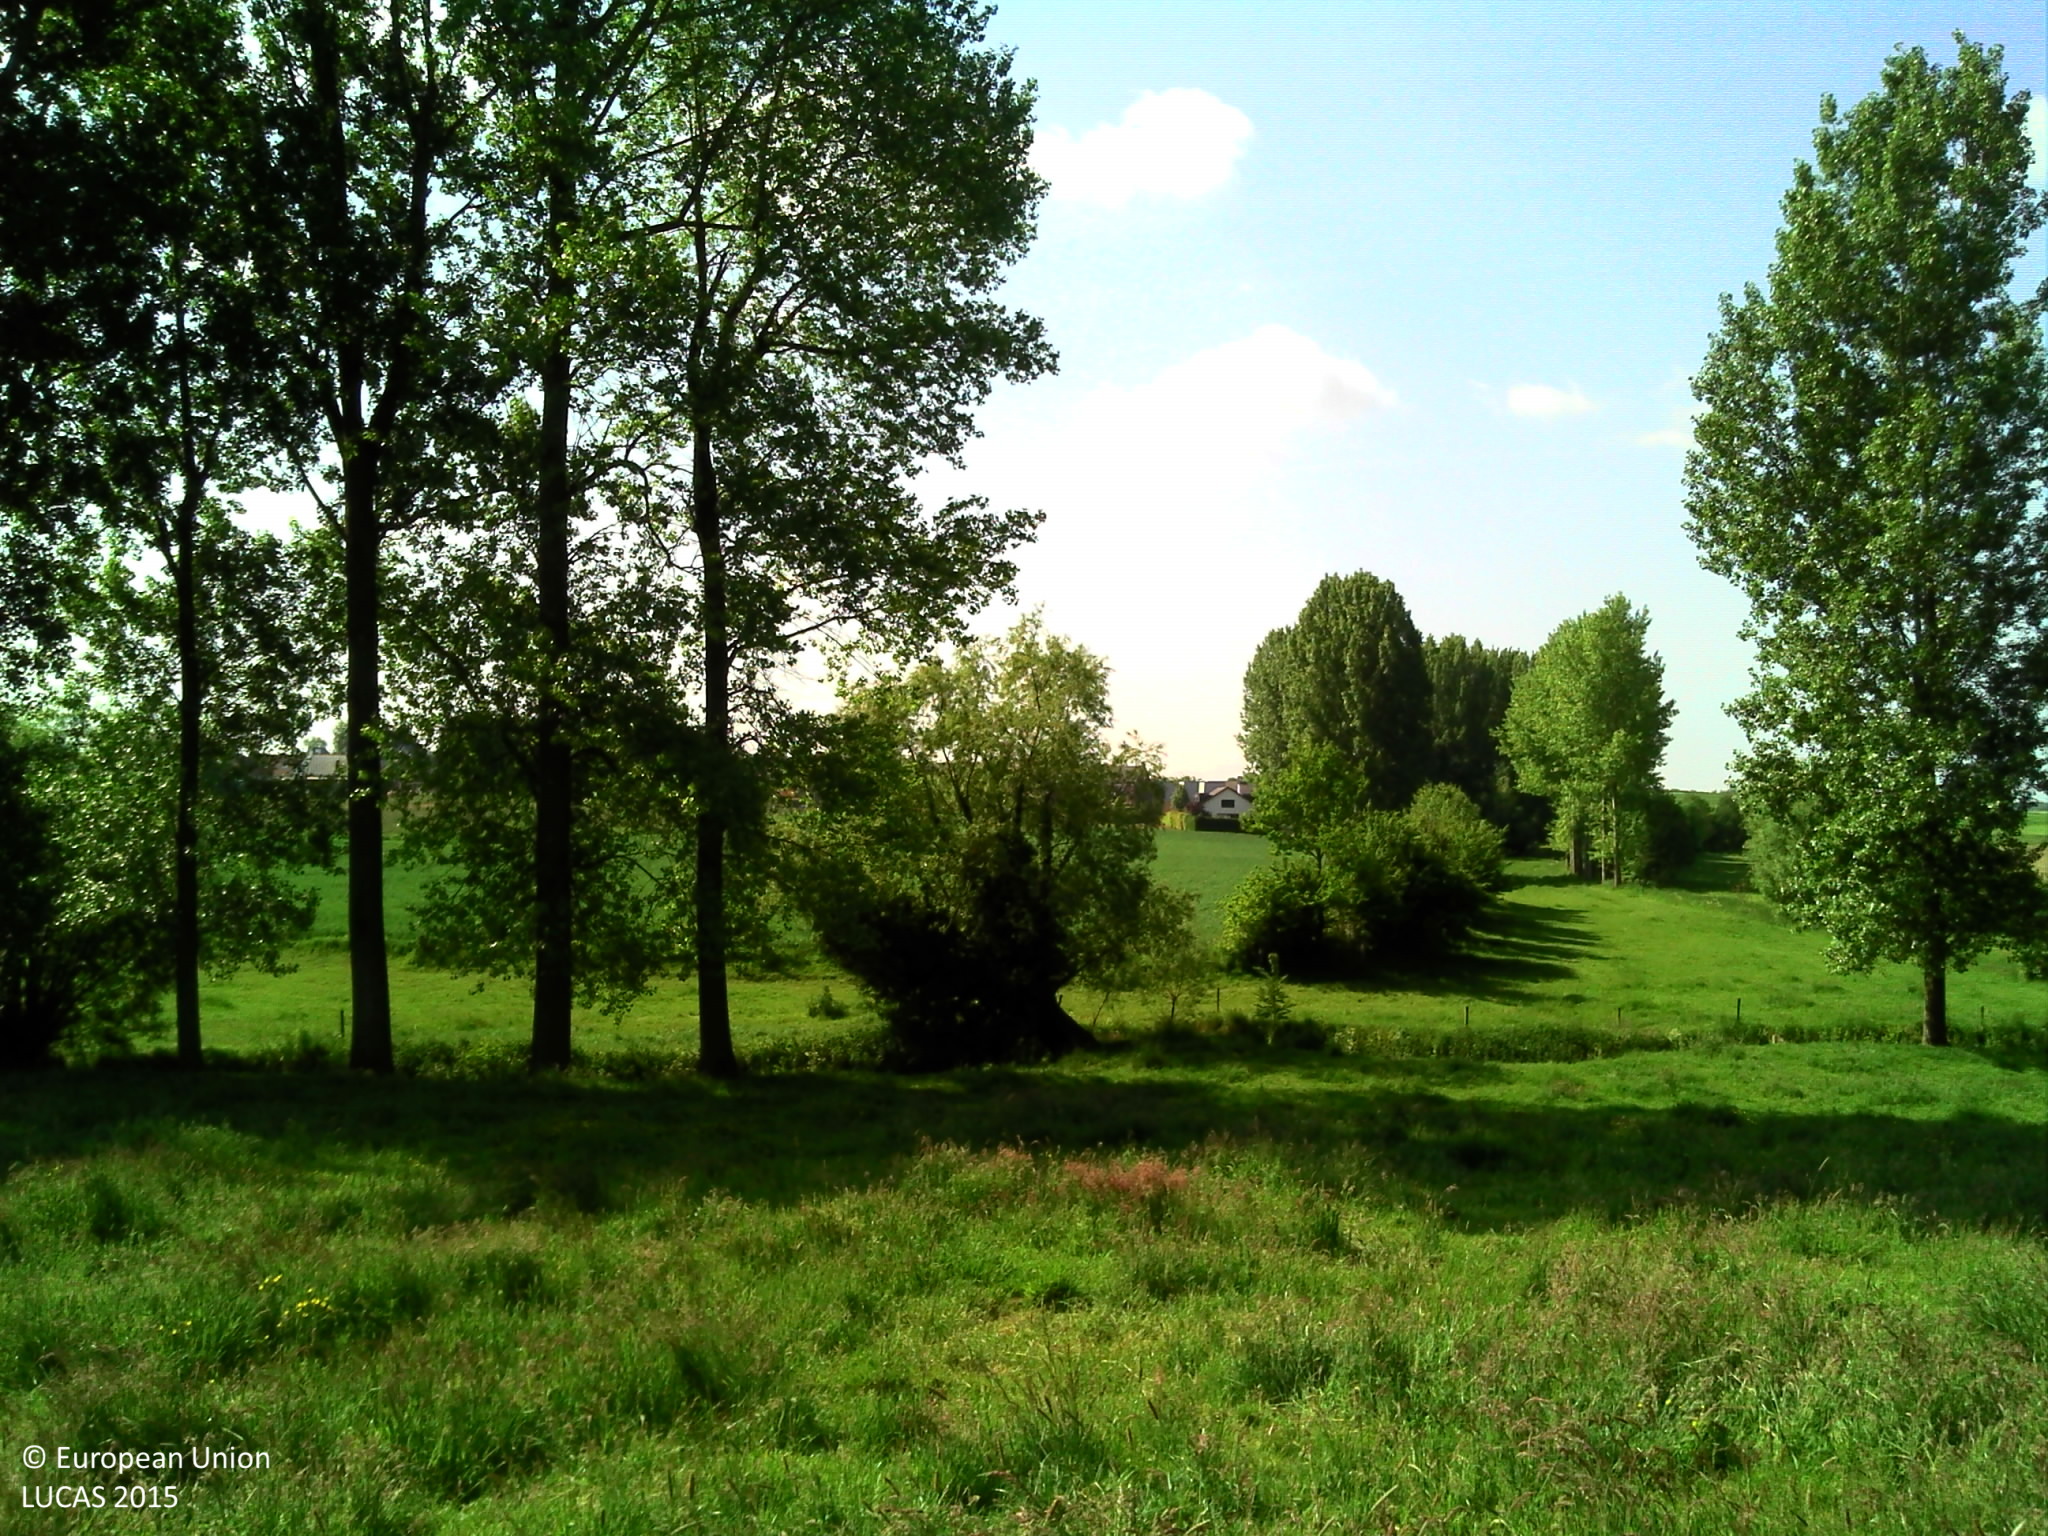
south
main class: Grassland
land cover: Grassland without tree/shrub cover
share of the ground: > 75 %
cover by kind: herbaceous plants 70 %, shrubs 5 %
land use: Agriculture (excluding fallow land and kitchen gardens)
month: May
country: BE
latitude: 50.7146
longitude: 4.0602
